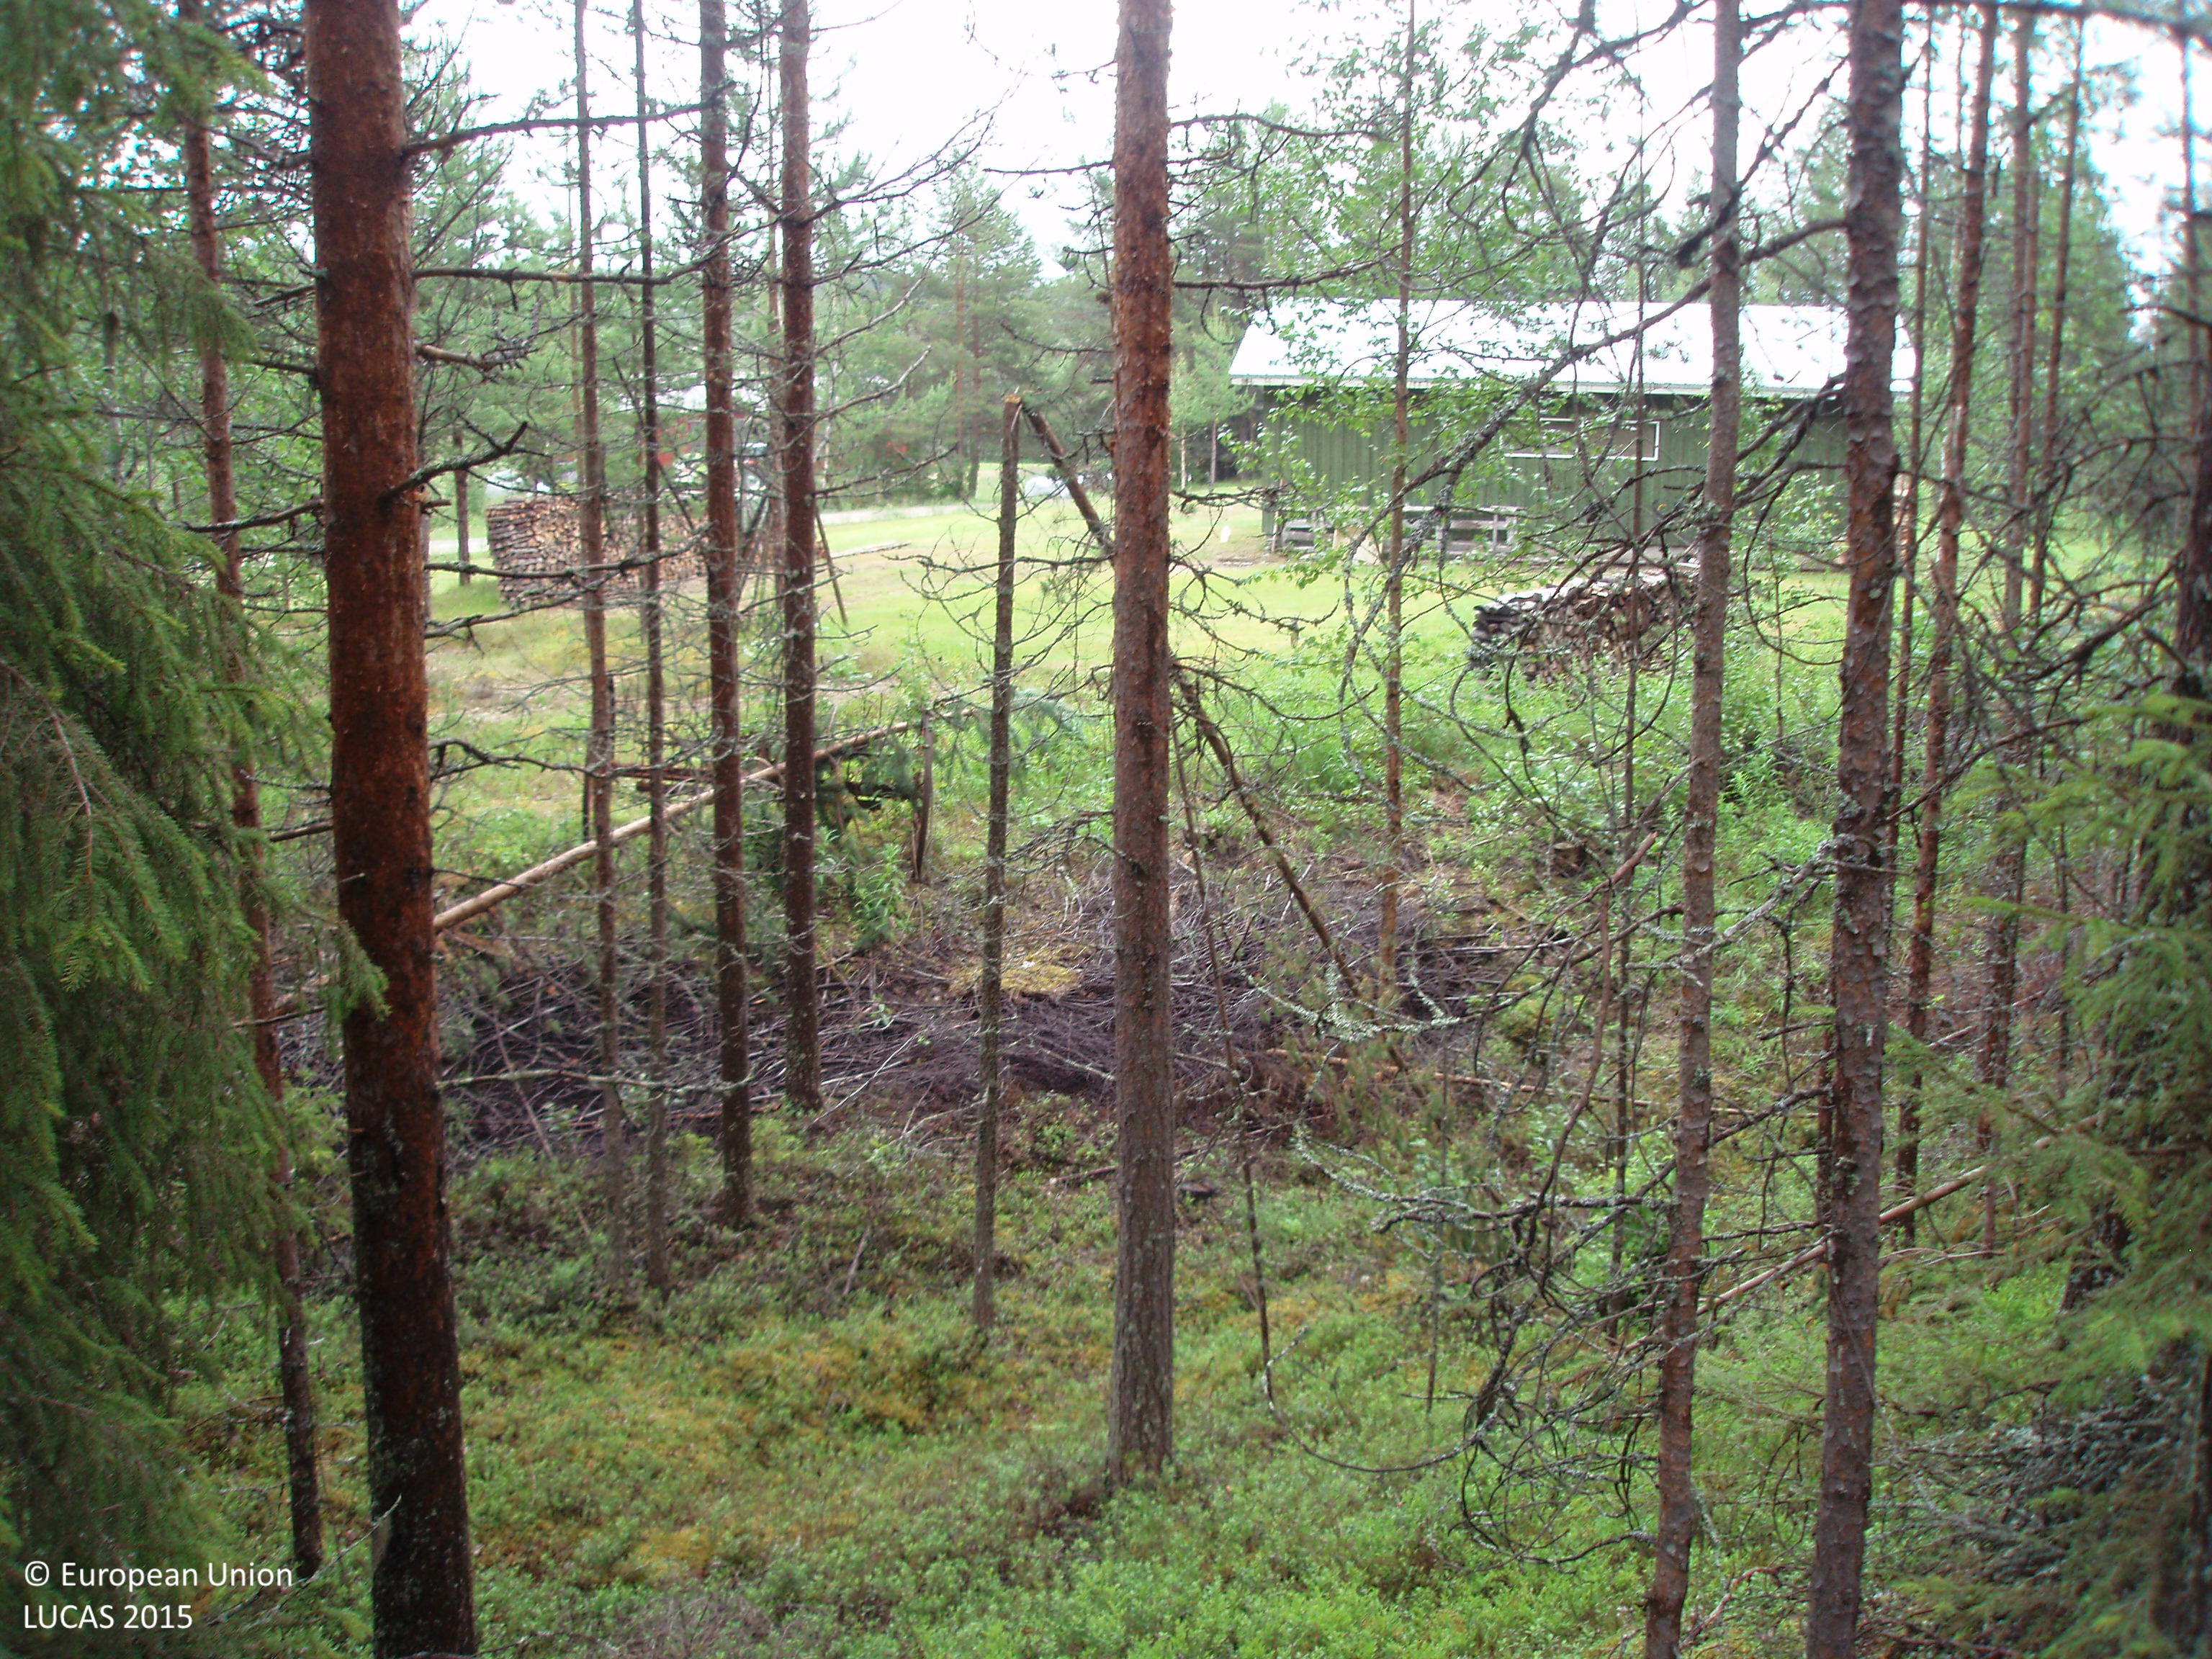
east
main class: Woodland
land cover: Pine dominated coniferous woodland
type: boreal forest
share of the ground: 50 - 75 %
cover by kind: coniferous forest trees 70 %, shrubs 30 %
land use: Forestry
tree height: > 5 m
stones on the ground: 10 - 25 %
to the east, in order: Pine dominated coniferous woodland; Grassland without tree/shrub cover; Ditches and canals; Tracks; Shruby margins; Pine dominated mixed woodland; Tracks; Pine dominated mixed woodland; Grassland without tree/shrub cover; Ditches and canals; Fences; Grassland without tree/shrub cover; Ditches and canals; Grassland without tree/shrub cover; Ditches and canals; Grassland without tree/shrub cover; Ditches and canals; Grassland without tree/shrub cover
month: July
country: FI
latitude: 67.2351
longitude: 28.4020
